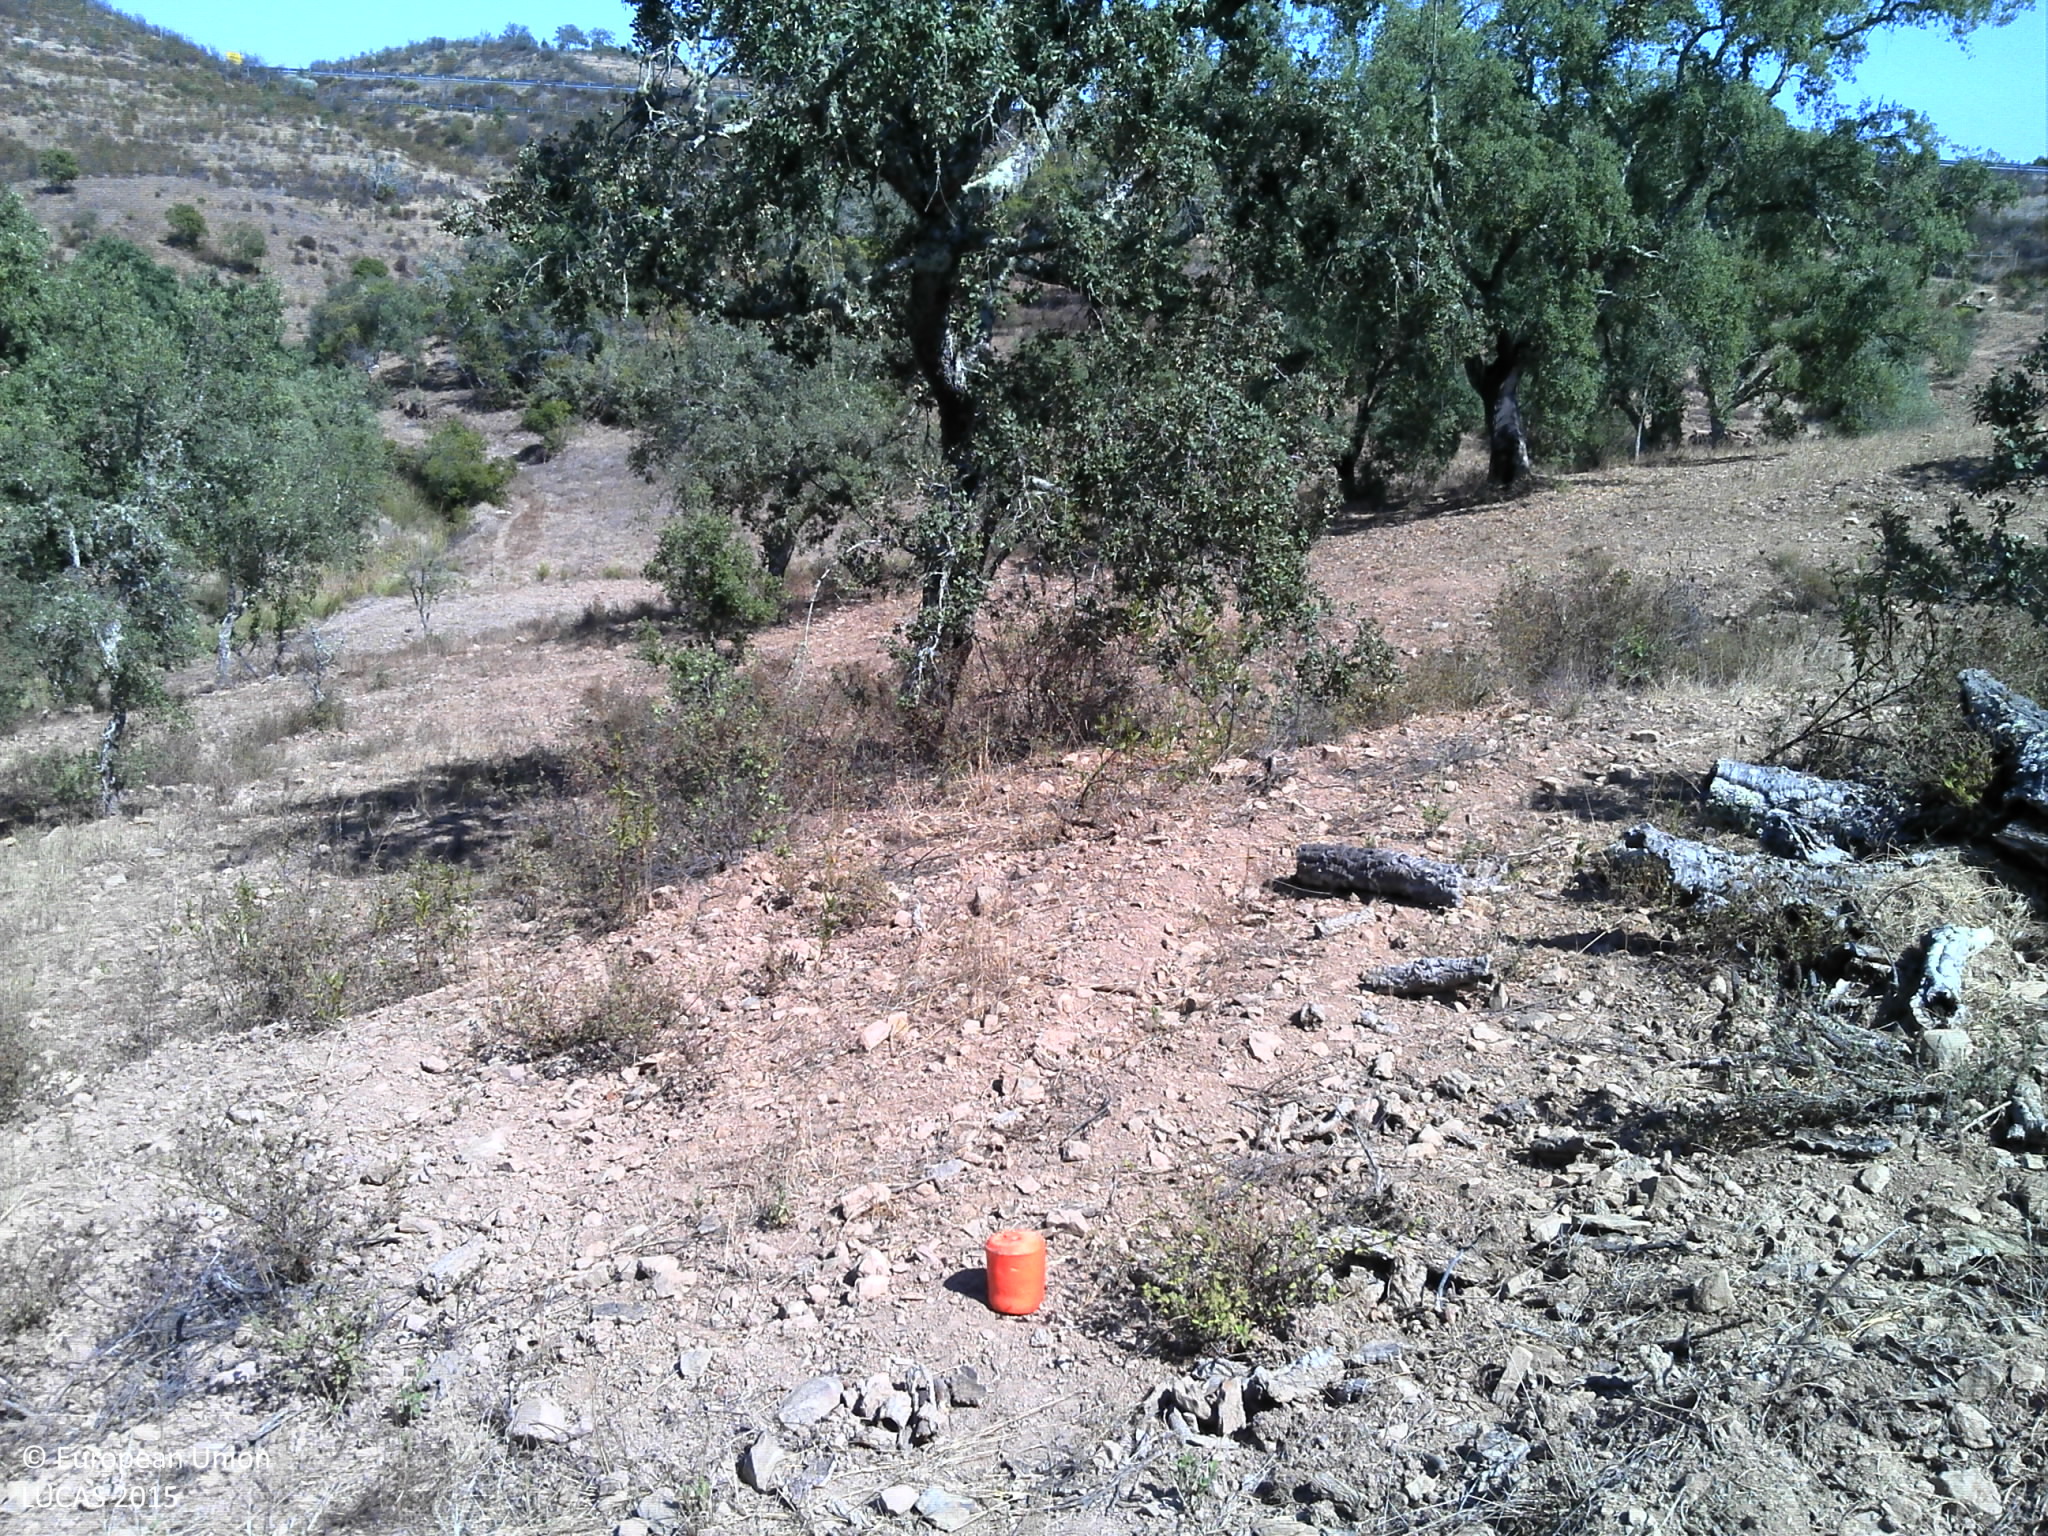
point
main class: Woodland
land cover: Broadleaved woodland
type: broadleaved evergreen forest
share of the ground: 25 - 50 %
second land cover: Grassland without tree/shrub cover
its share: 10 - 25 %
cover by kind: unconsolidated bare surface 45 %, broadleaved forest trees 30 %, herbaceous plants 20 %, shrubs 5 %
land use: Forestry
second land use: Agriculture (excluding fallow land and kitchen gardens)
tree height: > 5 m
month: September
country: PT
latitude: 37.4719
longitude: -8.2184
